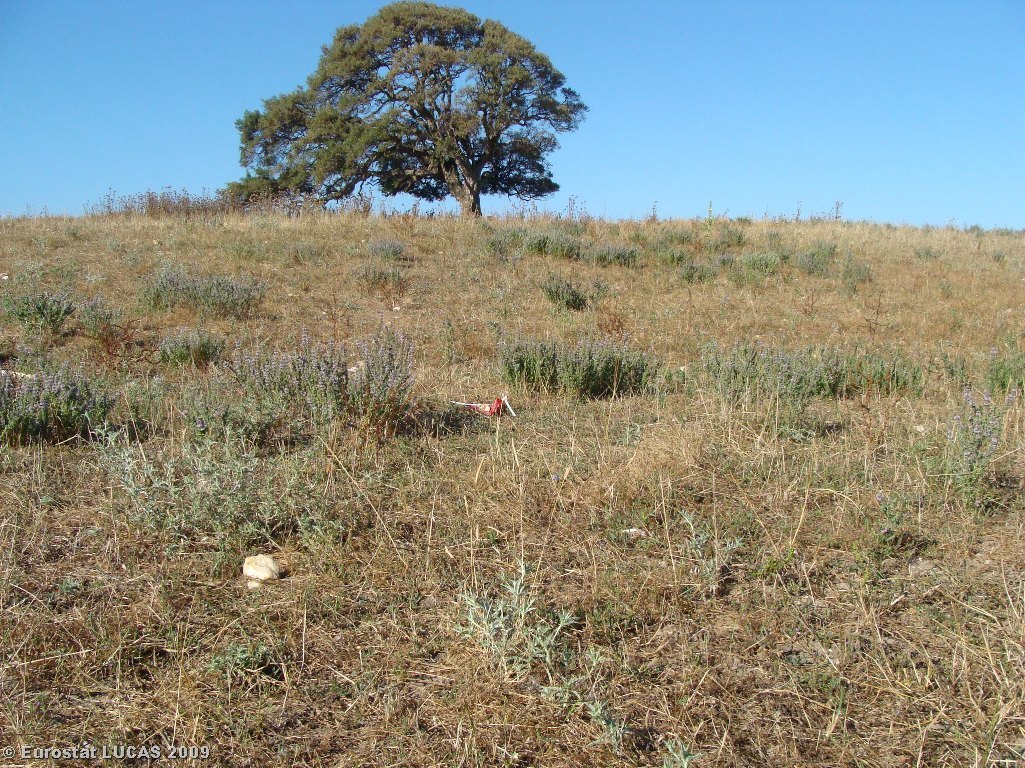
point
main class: Grassland
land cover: Grassland without tree/shrub cover
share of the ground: > 75 %
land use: Agriculture (excluding fallow land and kitchen gardens)
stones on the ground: < 10 %
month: June
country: IT
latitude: 40.7070
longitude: 8.4098
